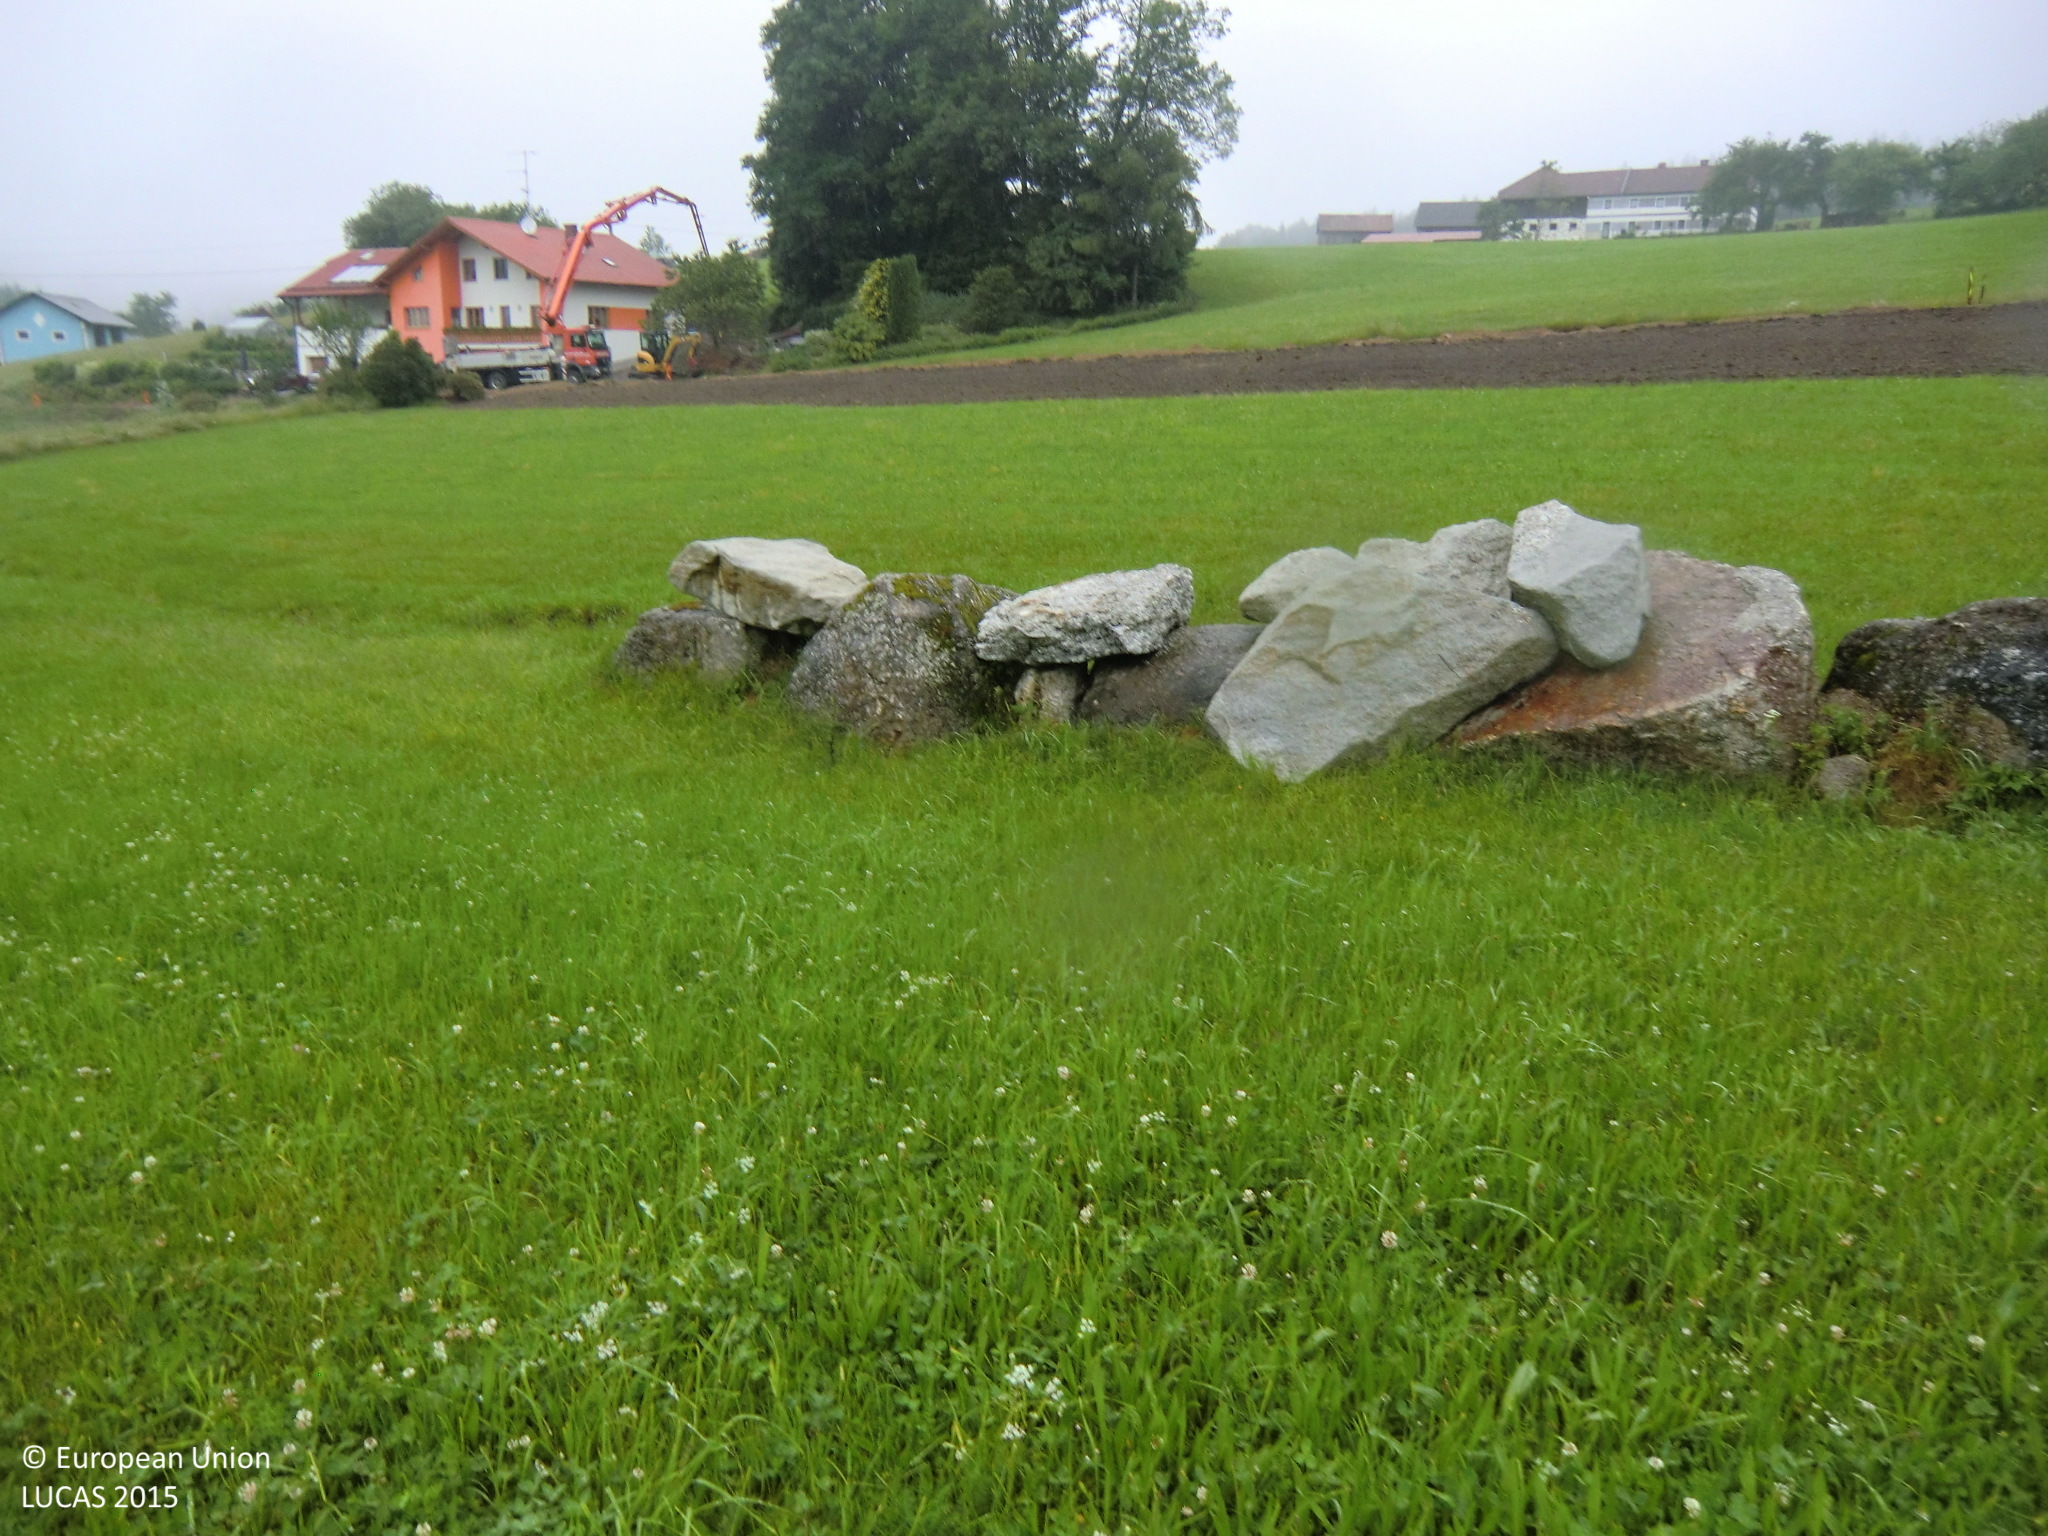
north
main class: Grassland
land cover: Grassland without tree/shrub cover
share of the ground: > 75 %
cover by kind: herbaceous plants 100 %
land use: Agriculture (excluding fallow land and kitchen gardens)
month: June
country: AT
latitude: 48.6142
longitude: 14.5992
